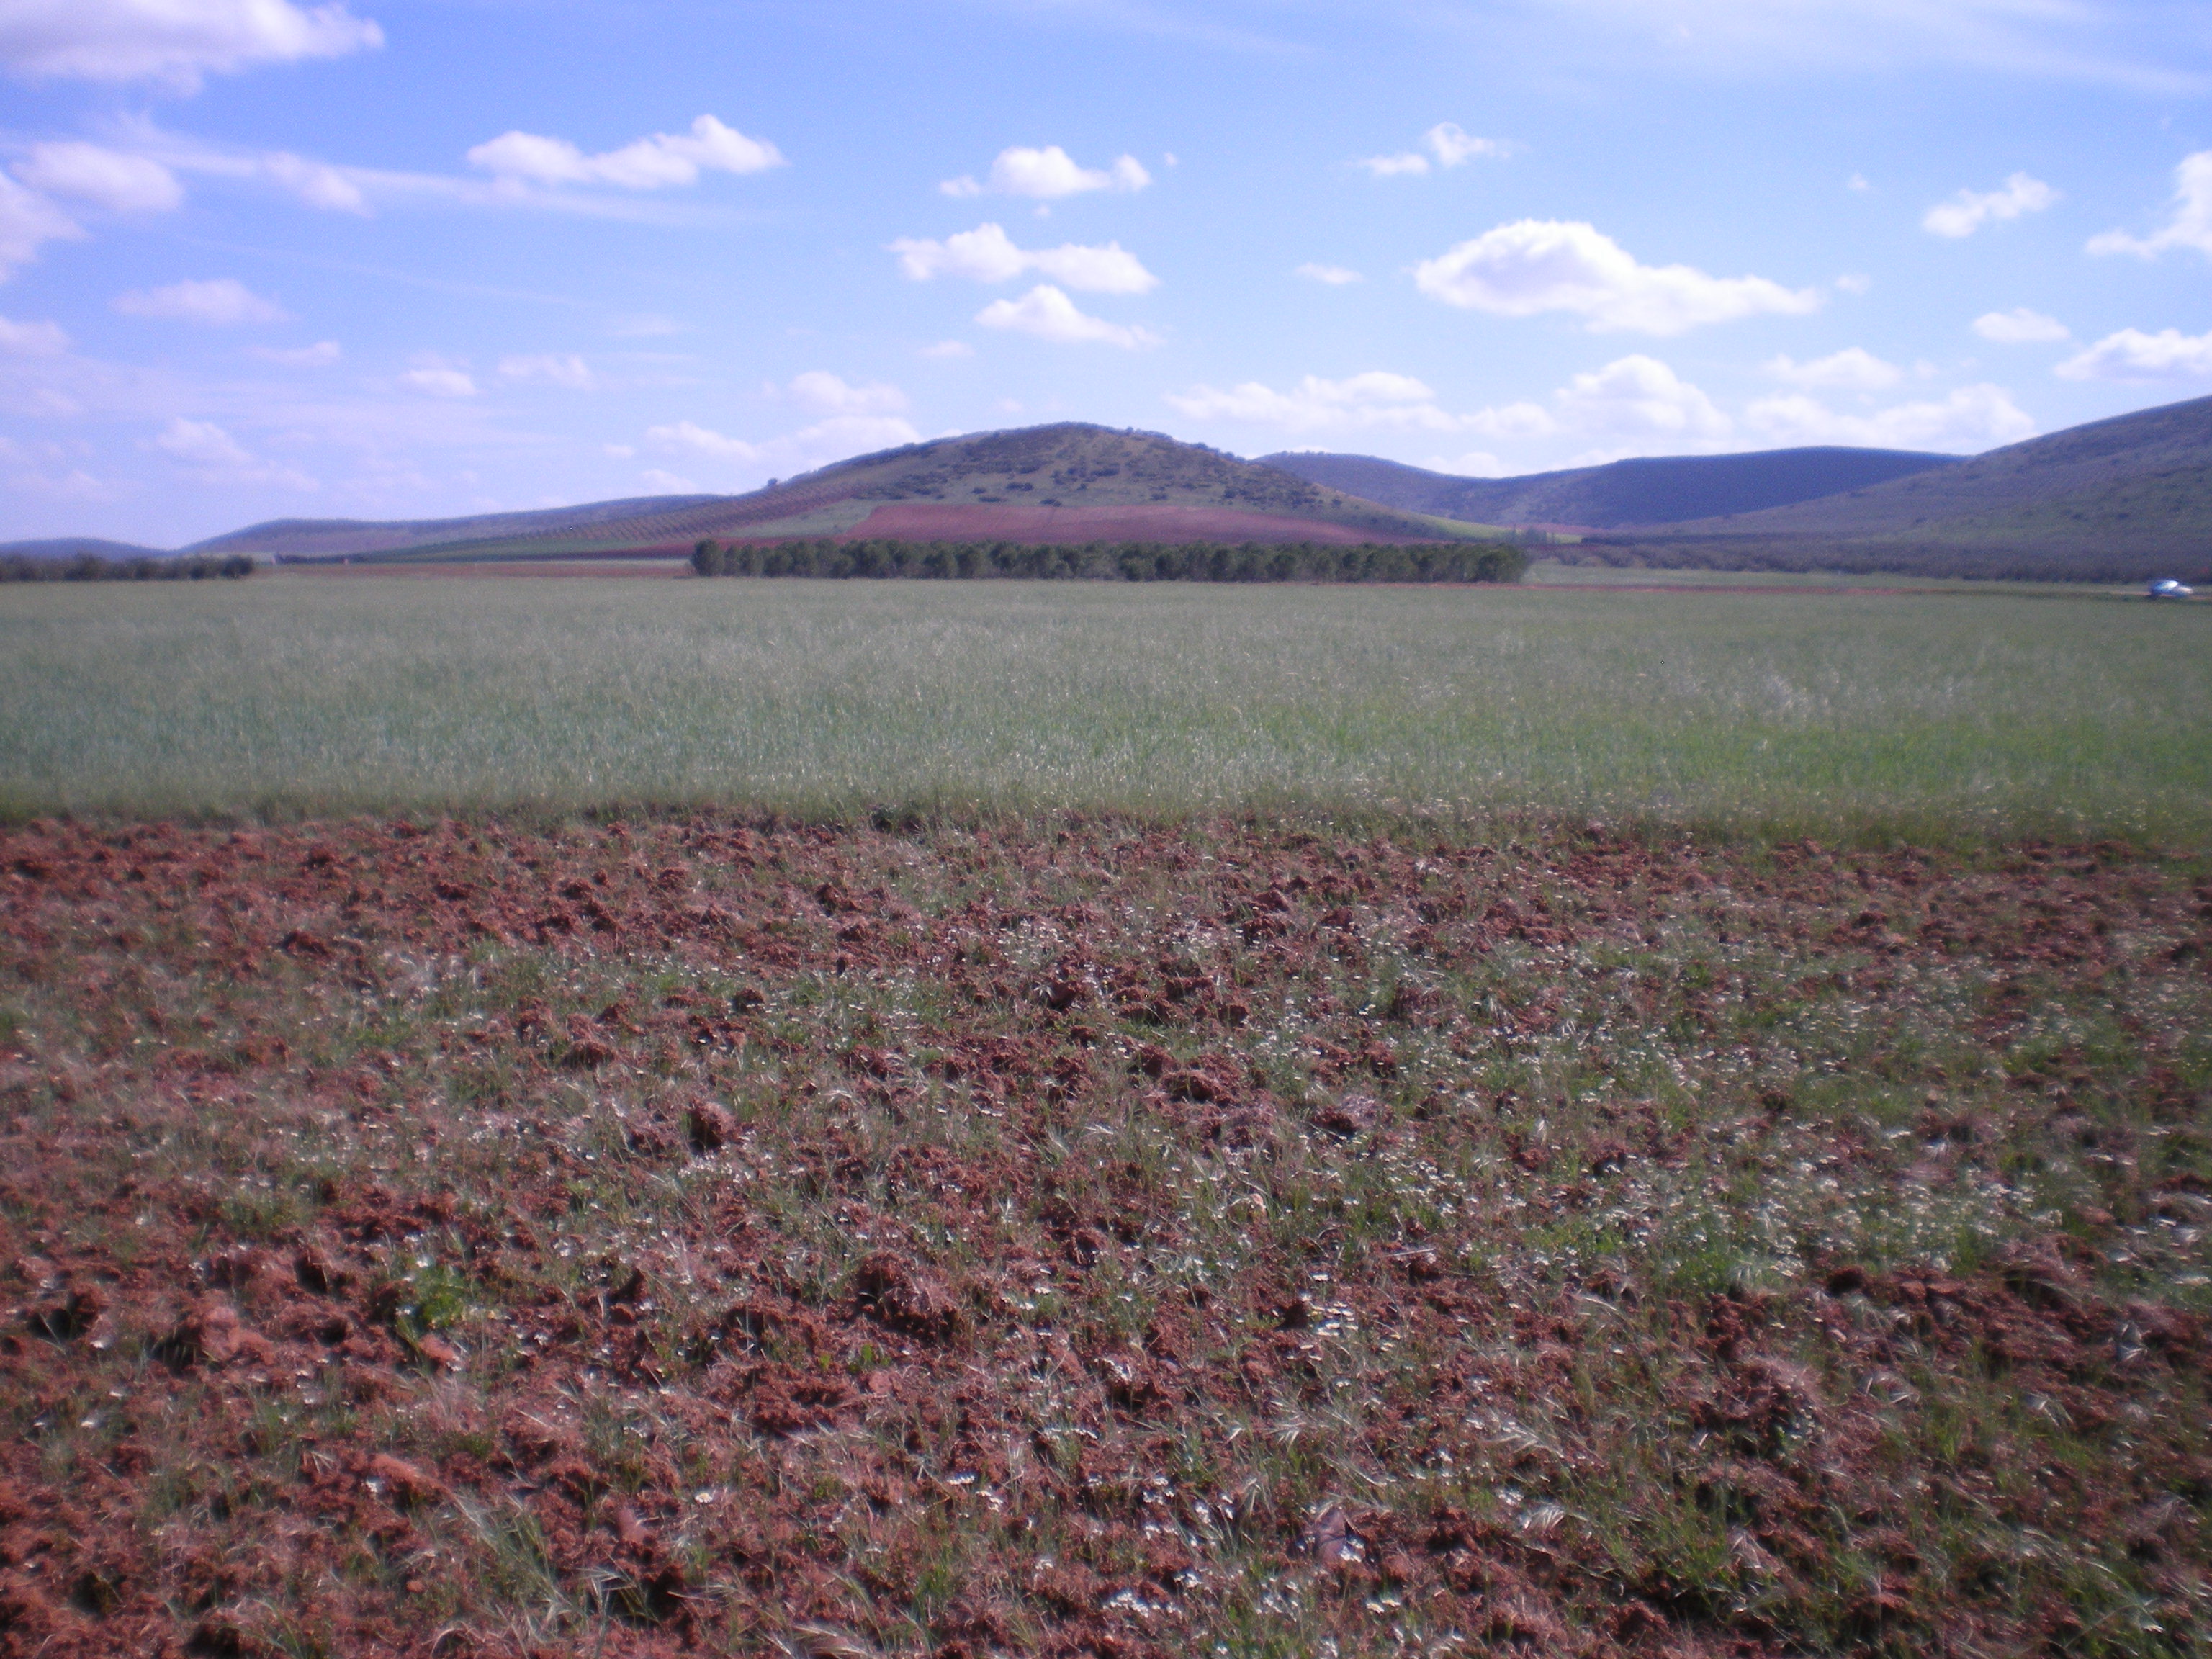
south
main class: Grassland
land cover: Spontaneously vegetated surfaces
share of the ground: 25 - 50 %
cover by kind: unconsolidated bare surface 70 %, herbaceous plants 30 %
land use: Fallow land
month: April
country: ES
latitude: 38.6822
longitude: -3.5417
